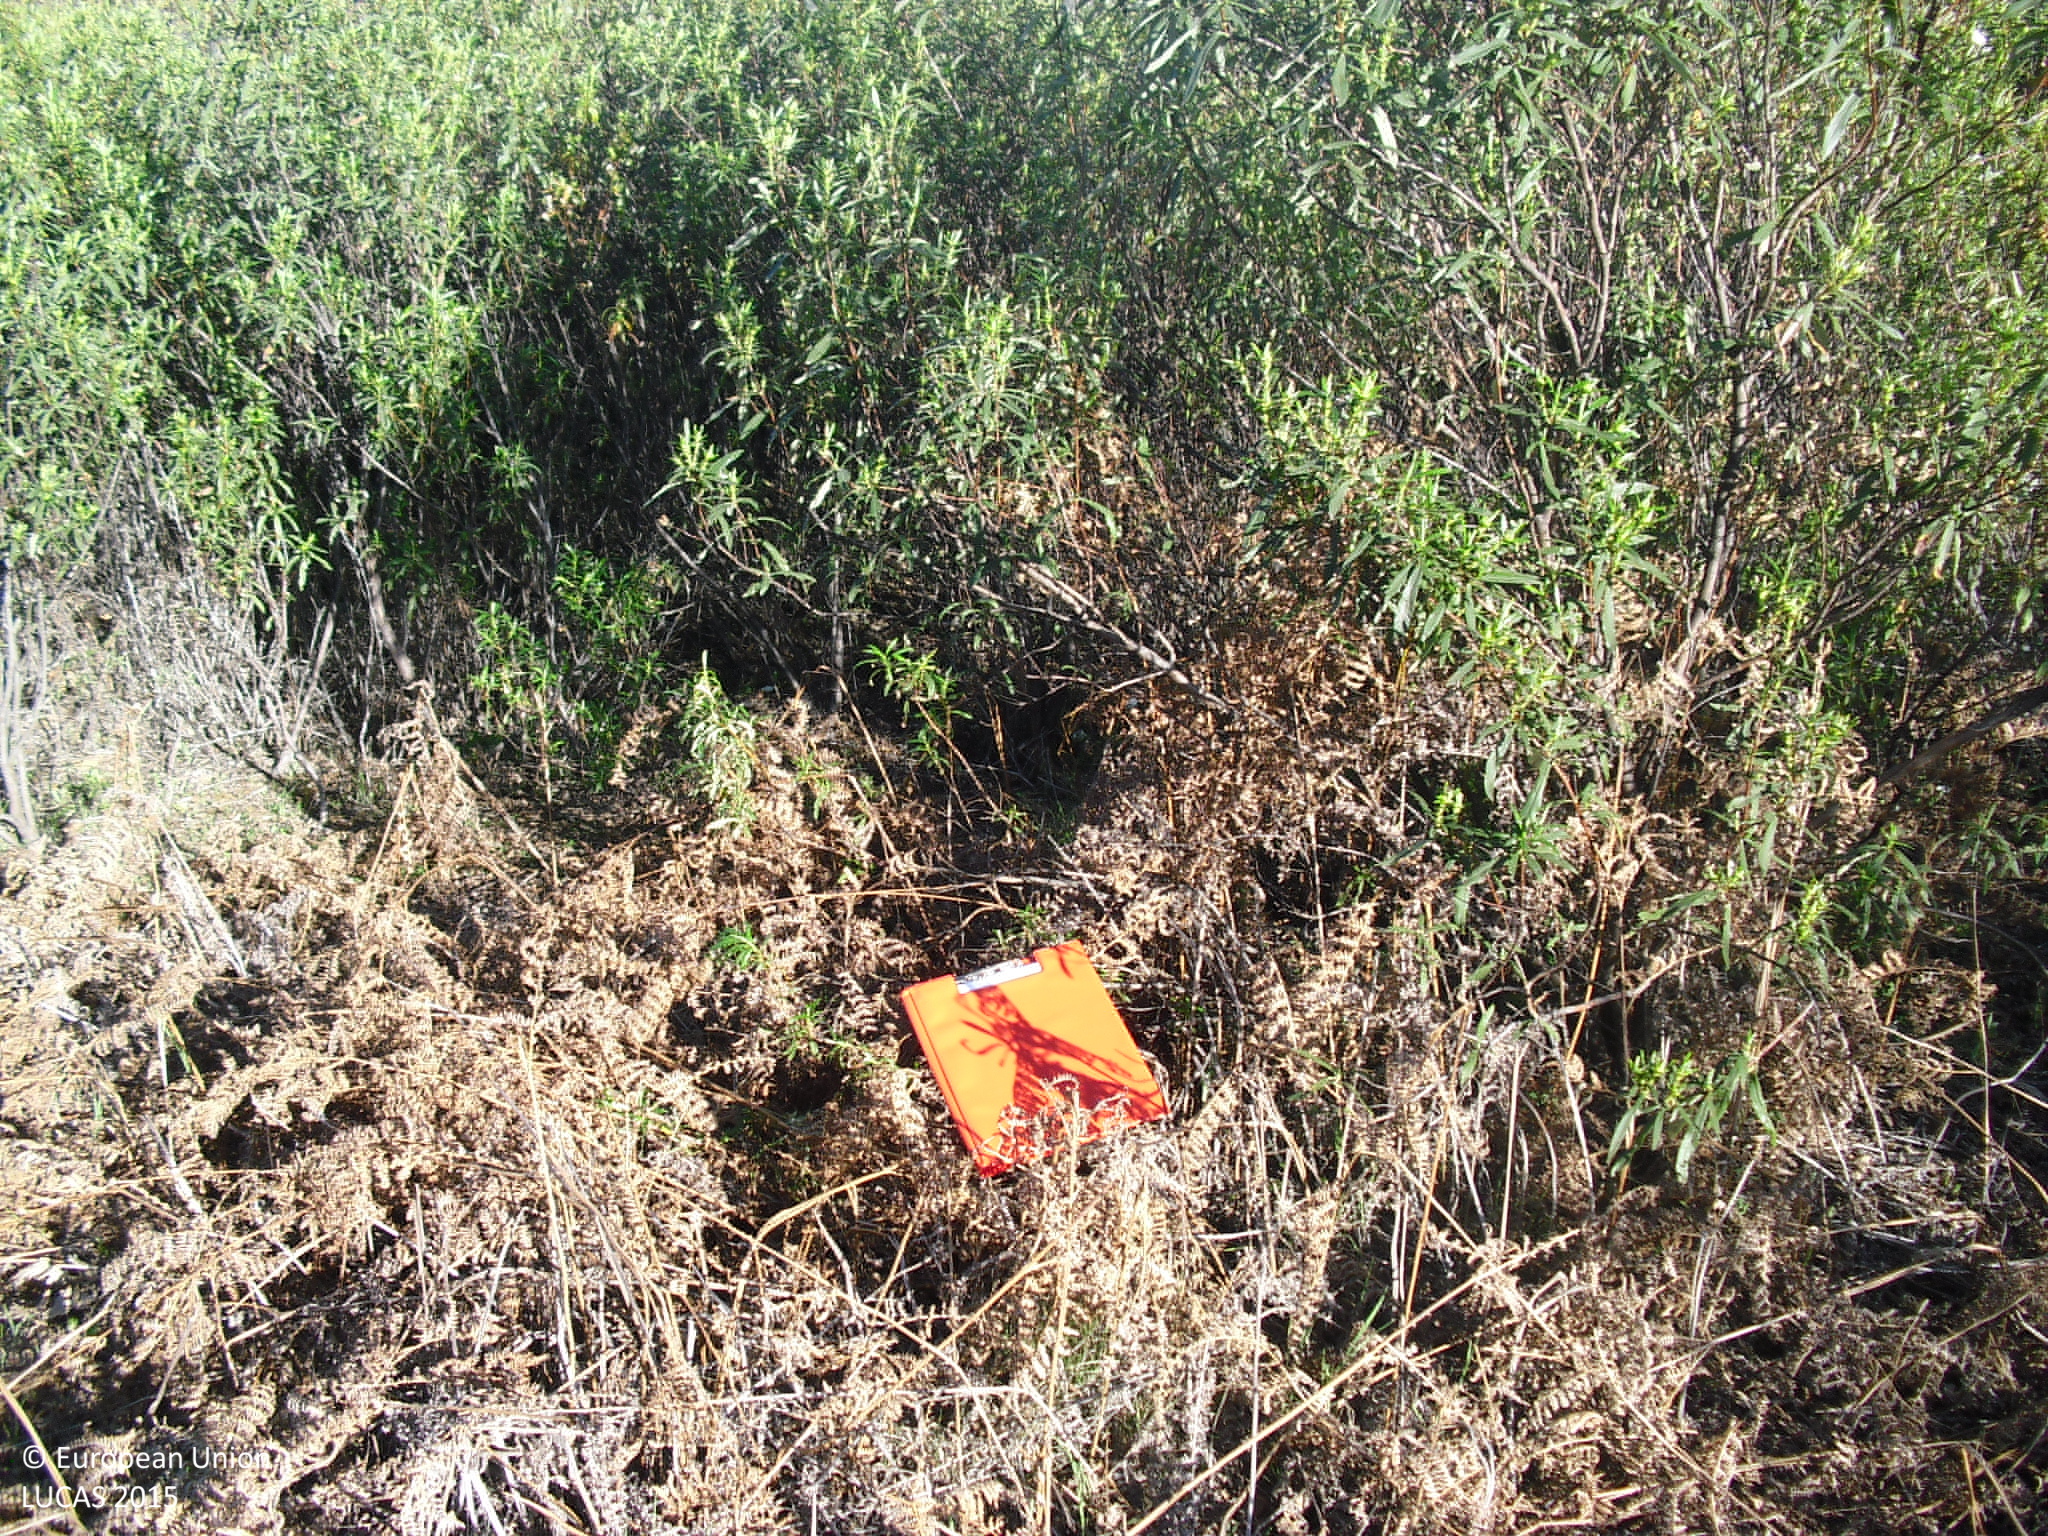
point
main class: Shrubland
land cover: Shrubland with sparse tree cover
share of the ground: 10 - 25 %
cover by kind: shrubs 85 %, herbaceous plants 10 %, broadleaved forest trees 5 %
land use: Semi-natural and natural areas not in use
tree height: > 5 m
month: April
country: ES
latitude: 39.4019
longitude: -5.3415
